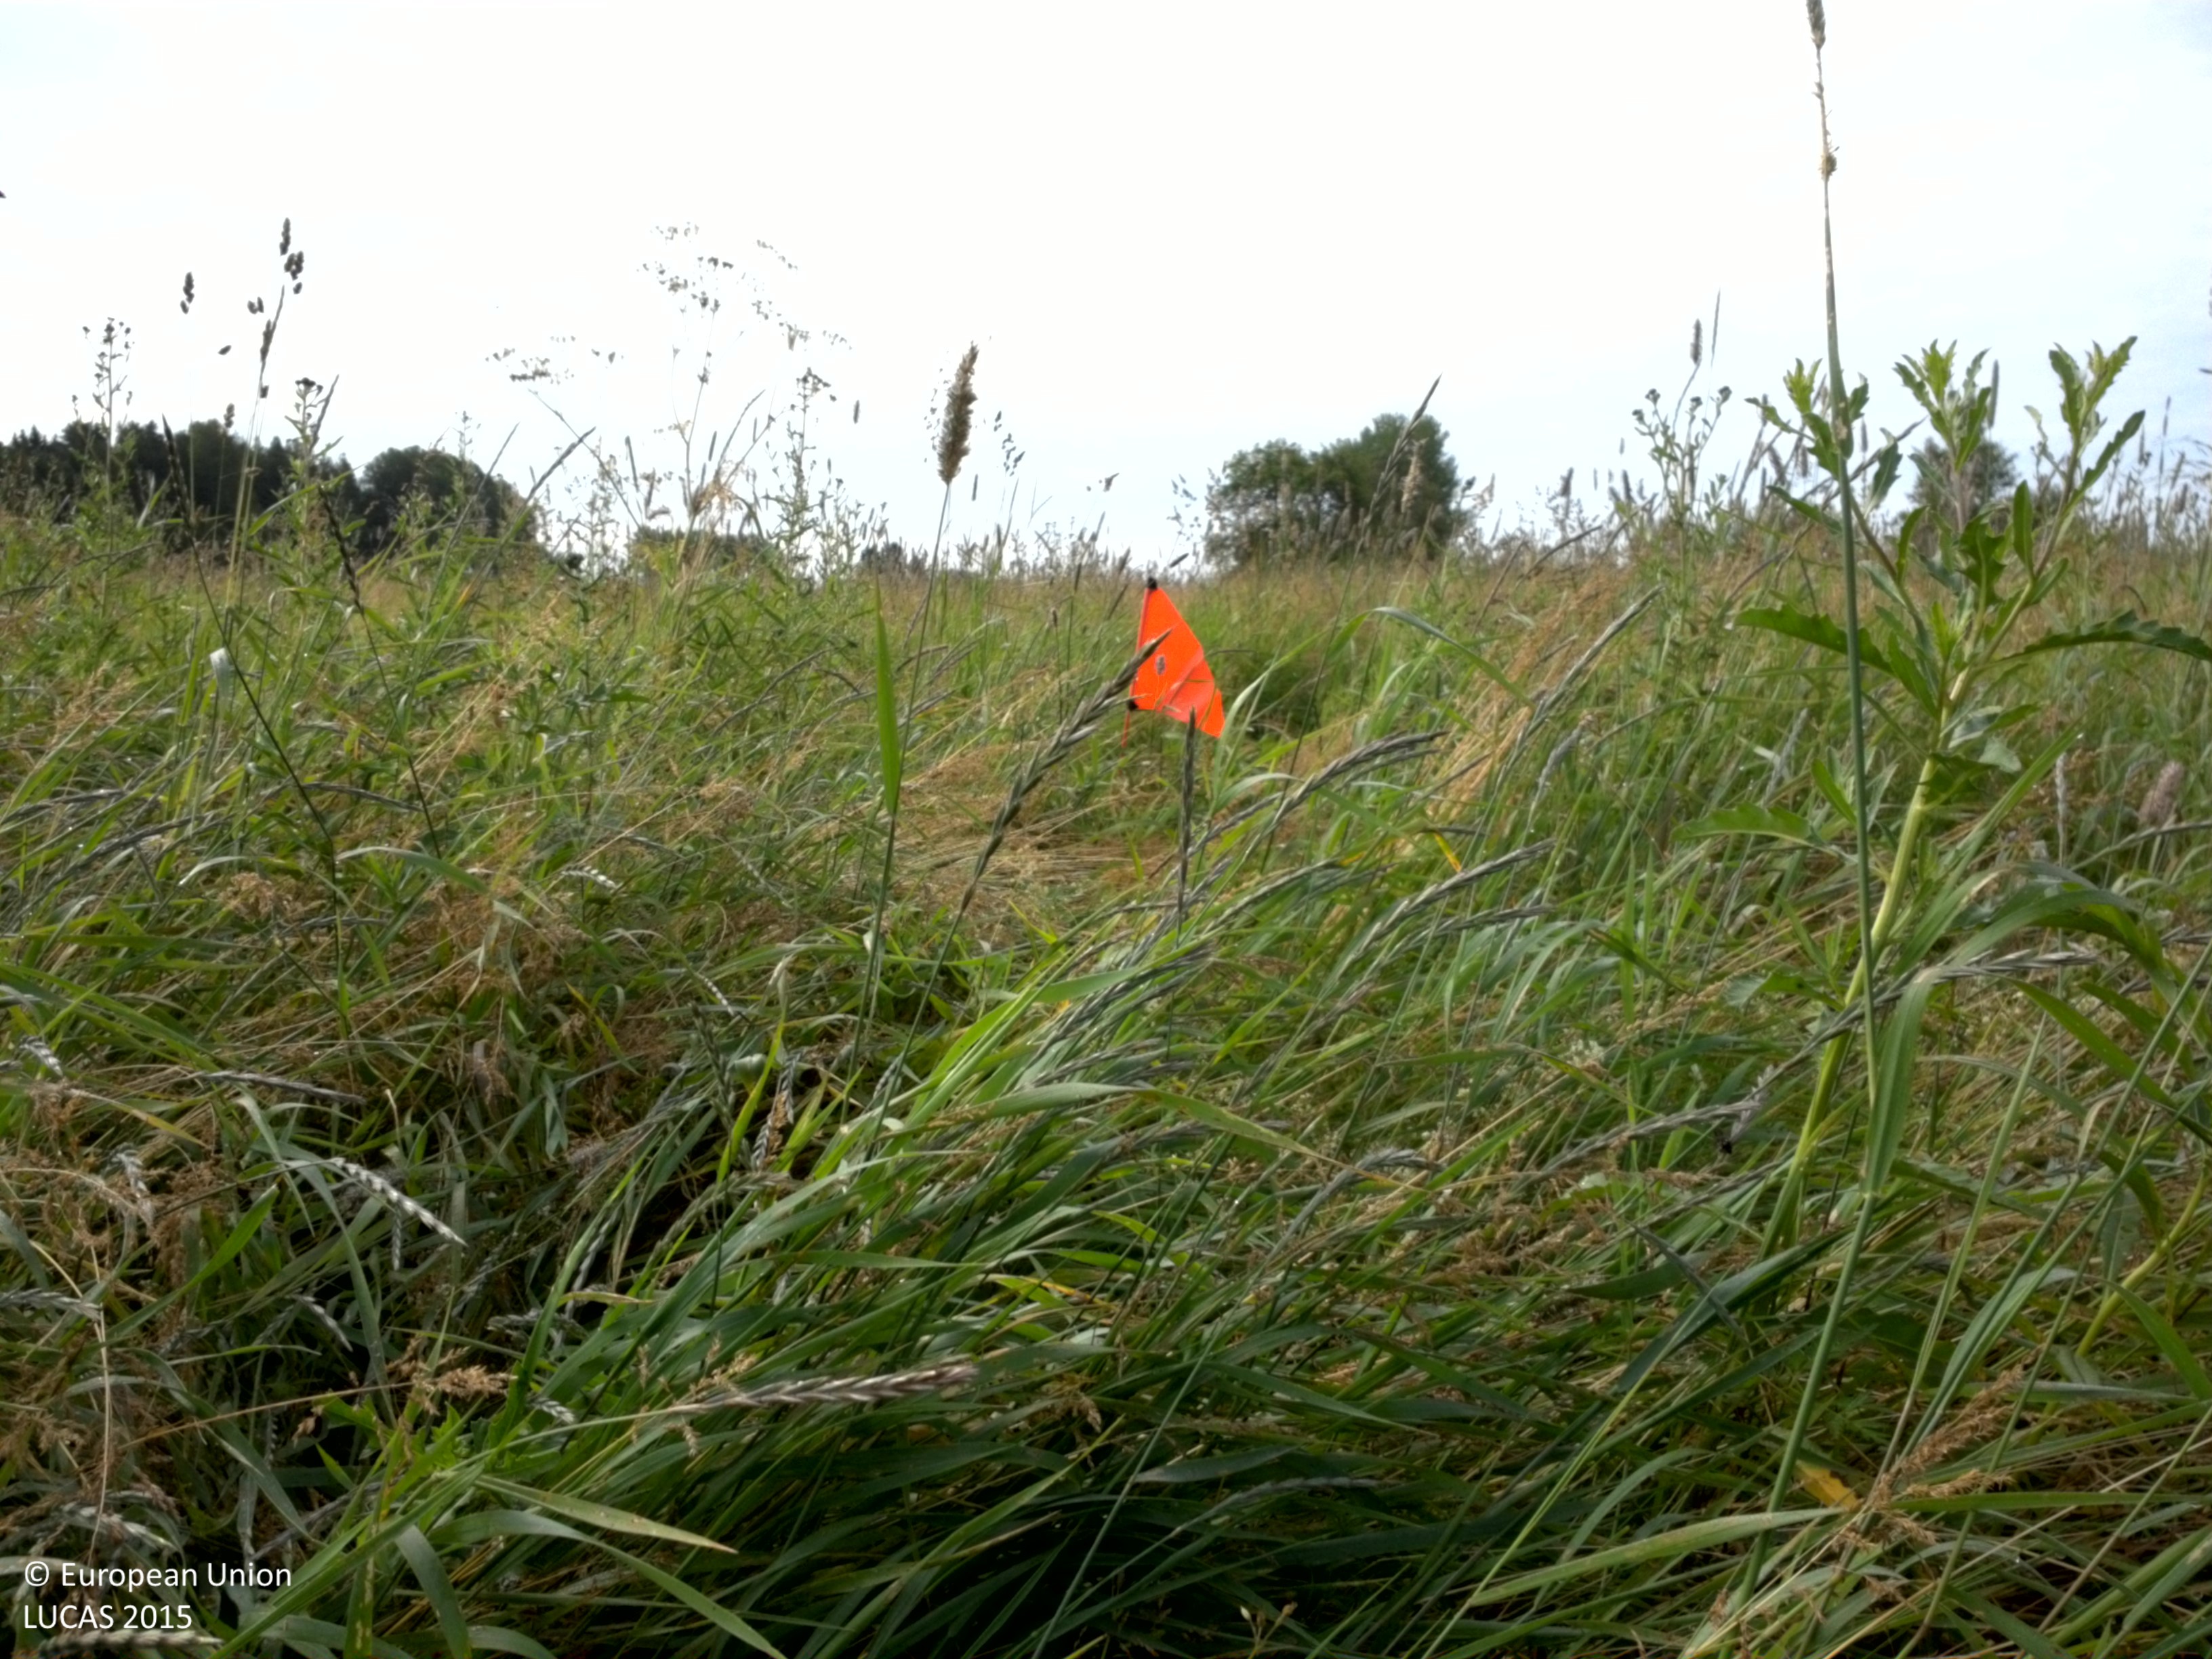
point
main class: Grassland
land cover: Grassland without tree/shrub cover
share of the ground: > 75 %
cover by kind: herbaceous plants 100 %
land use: Agriculture (excluding fallow land and kitchen gardens)
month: July
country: SE
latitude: 59.9624
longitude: 18.7572
